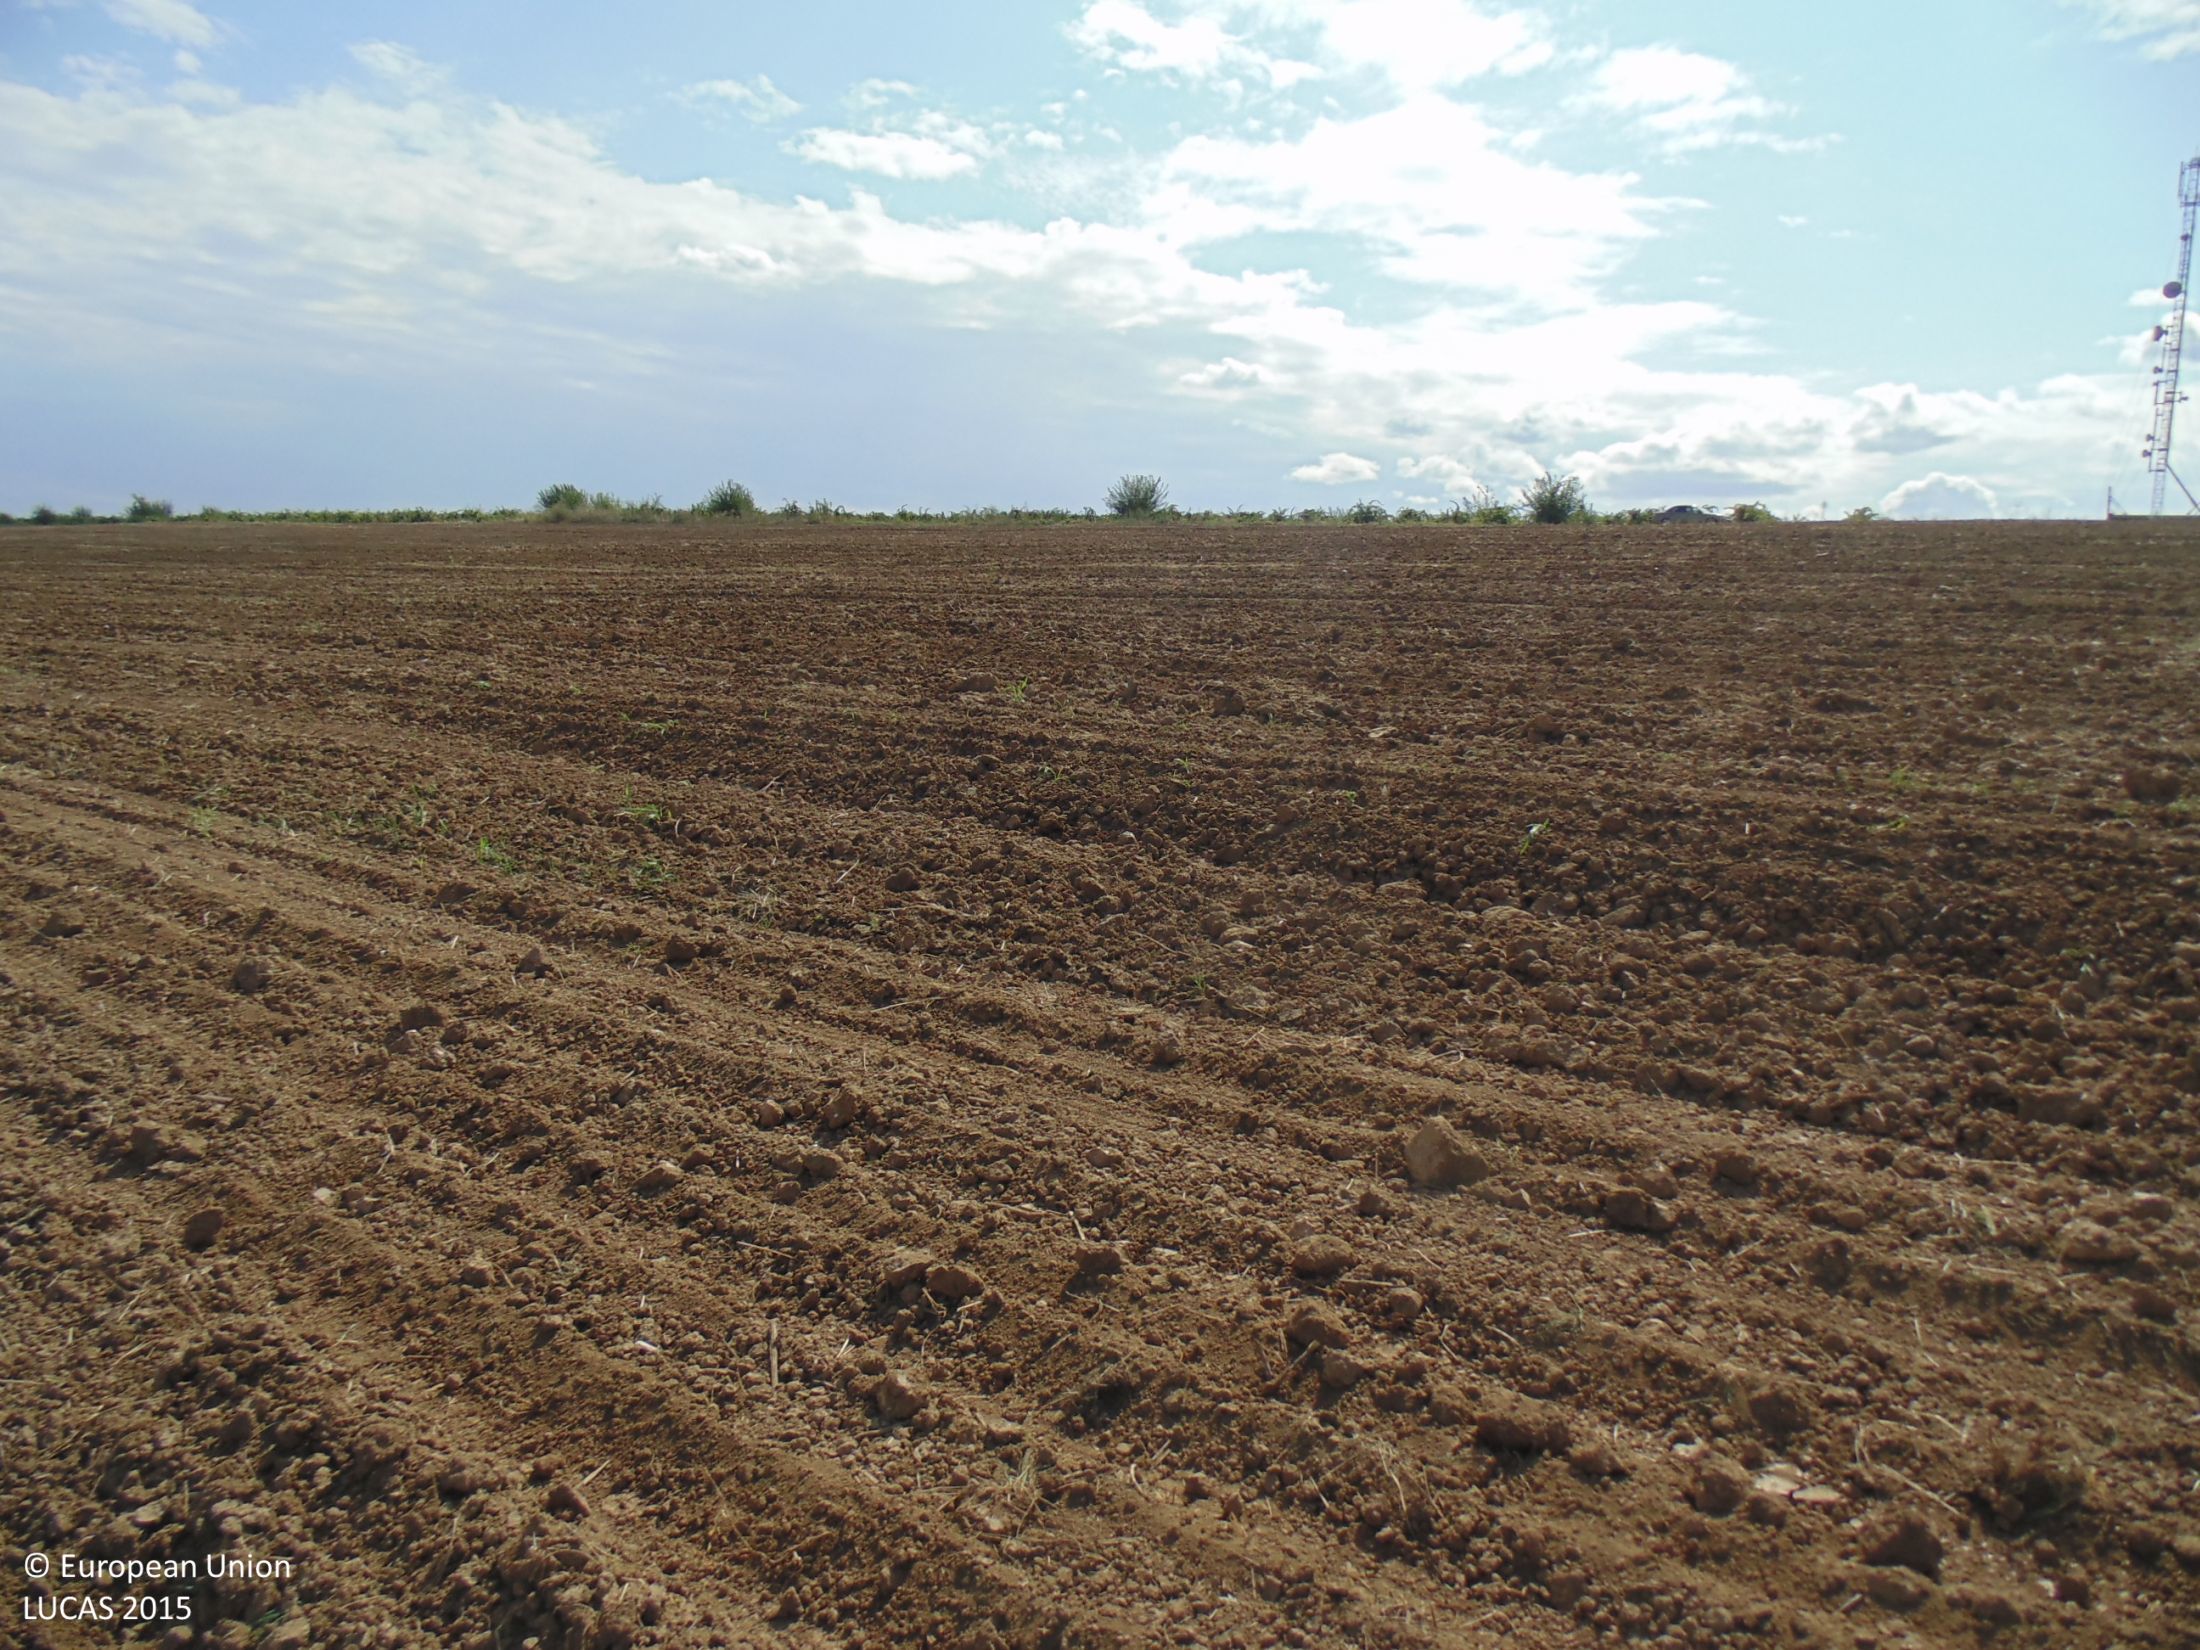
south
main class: Cropland
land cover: Common wheat
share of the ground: < 10 %
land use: Agriculture (excluding fallow land and kitchen gardens)
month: September
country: BG
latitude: 44.1133
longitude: 27.1078
